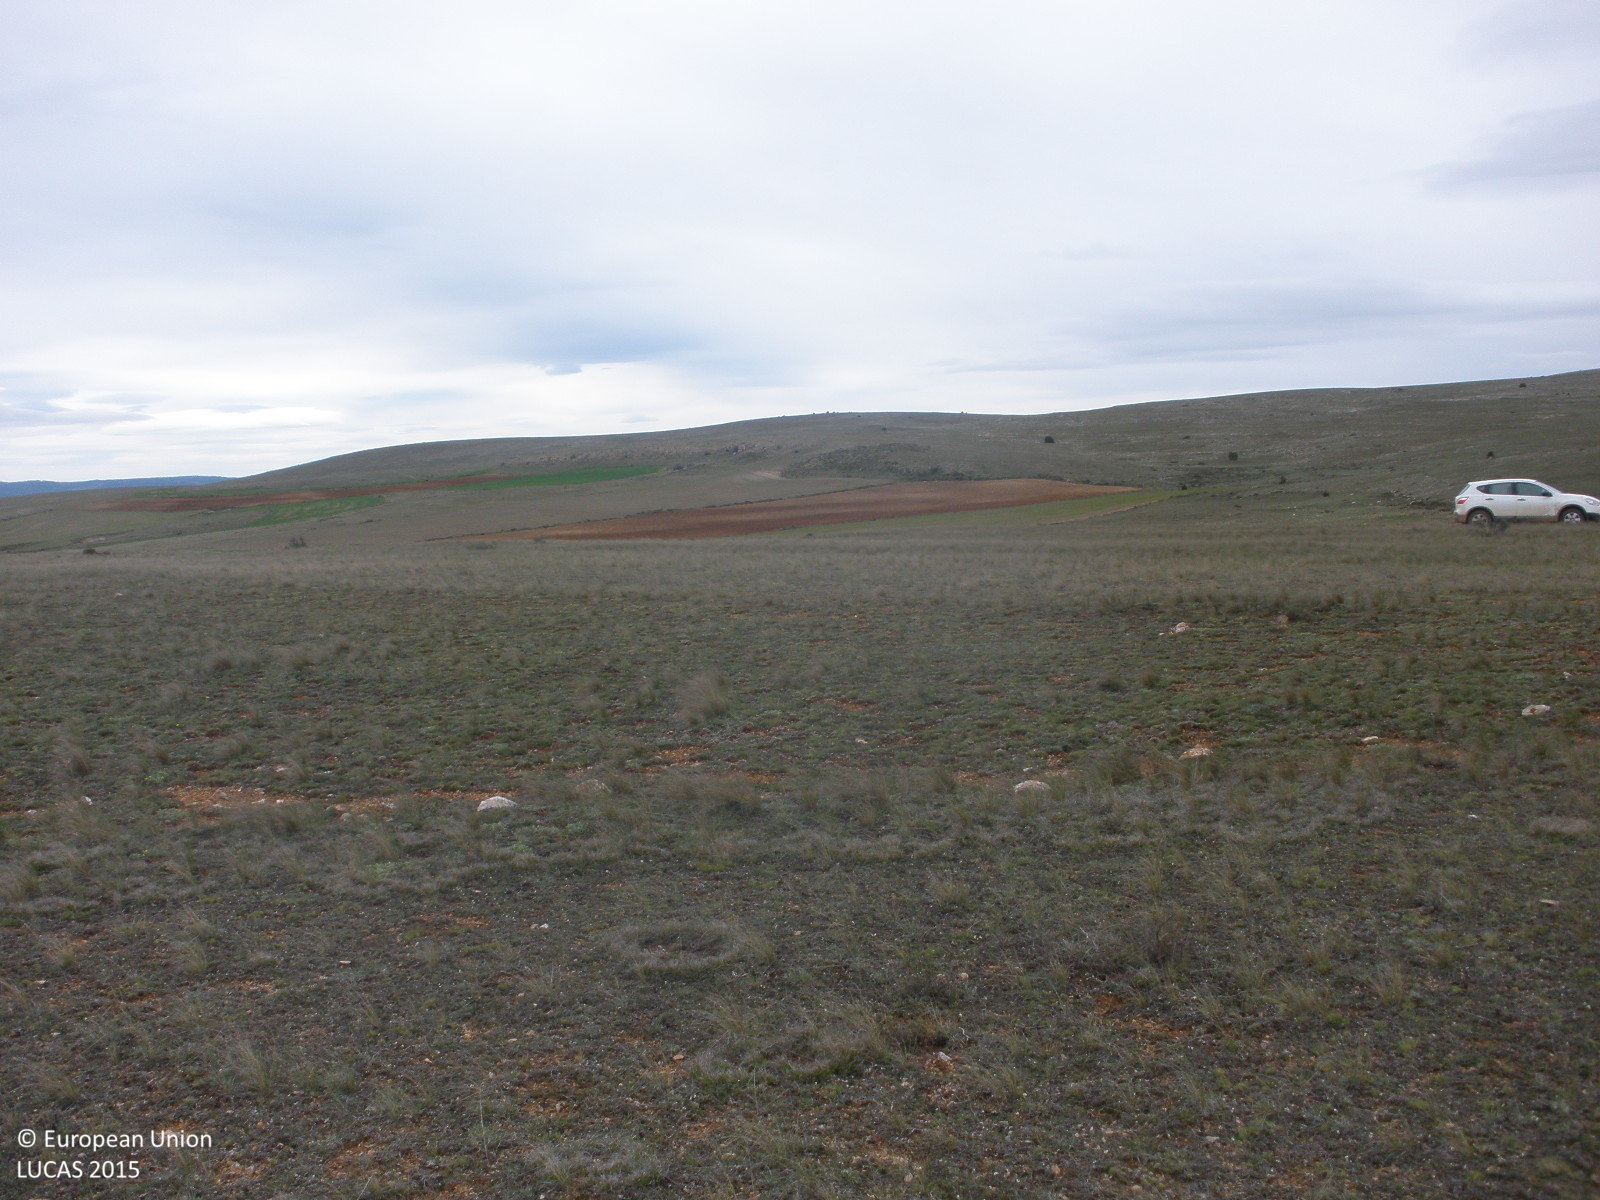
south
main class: Grassland
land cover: Grassland without tree/shrub cover
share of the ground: > 75 %
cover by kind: herbaceous plants 90 %, consolidated bare surface 10 %
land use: Semi-natural and natural areas not in use
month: May
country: ES
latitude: 40.5558
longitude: -0.8641
